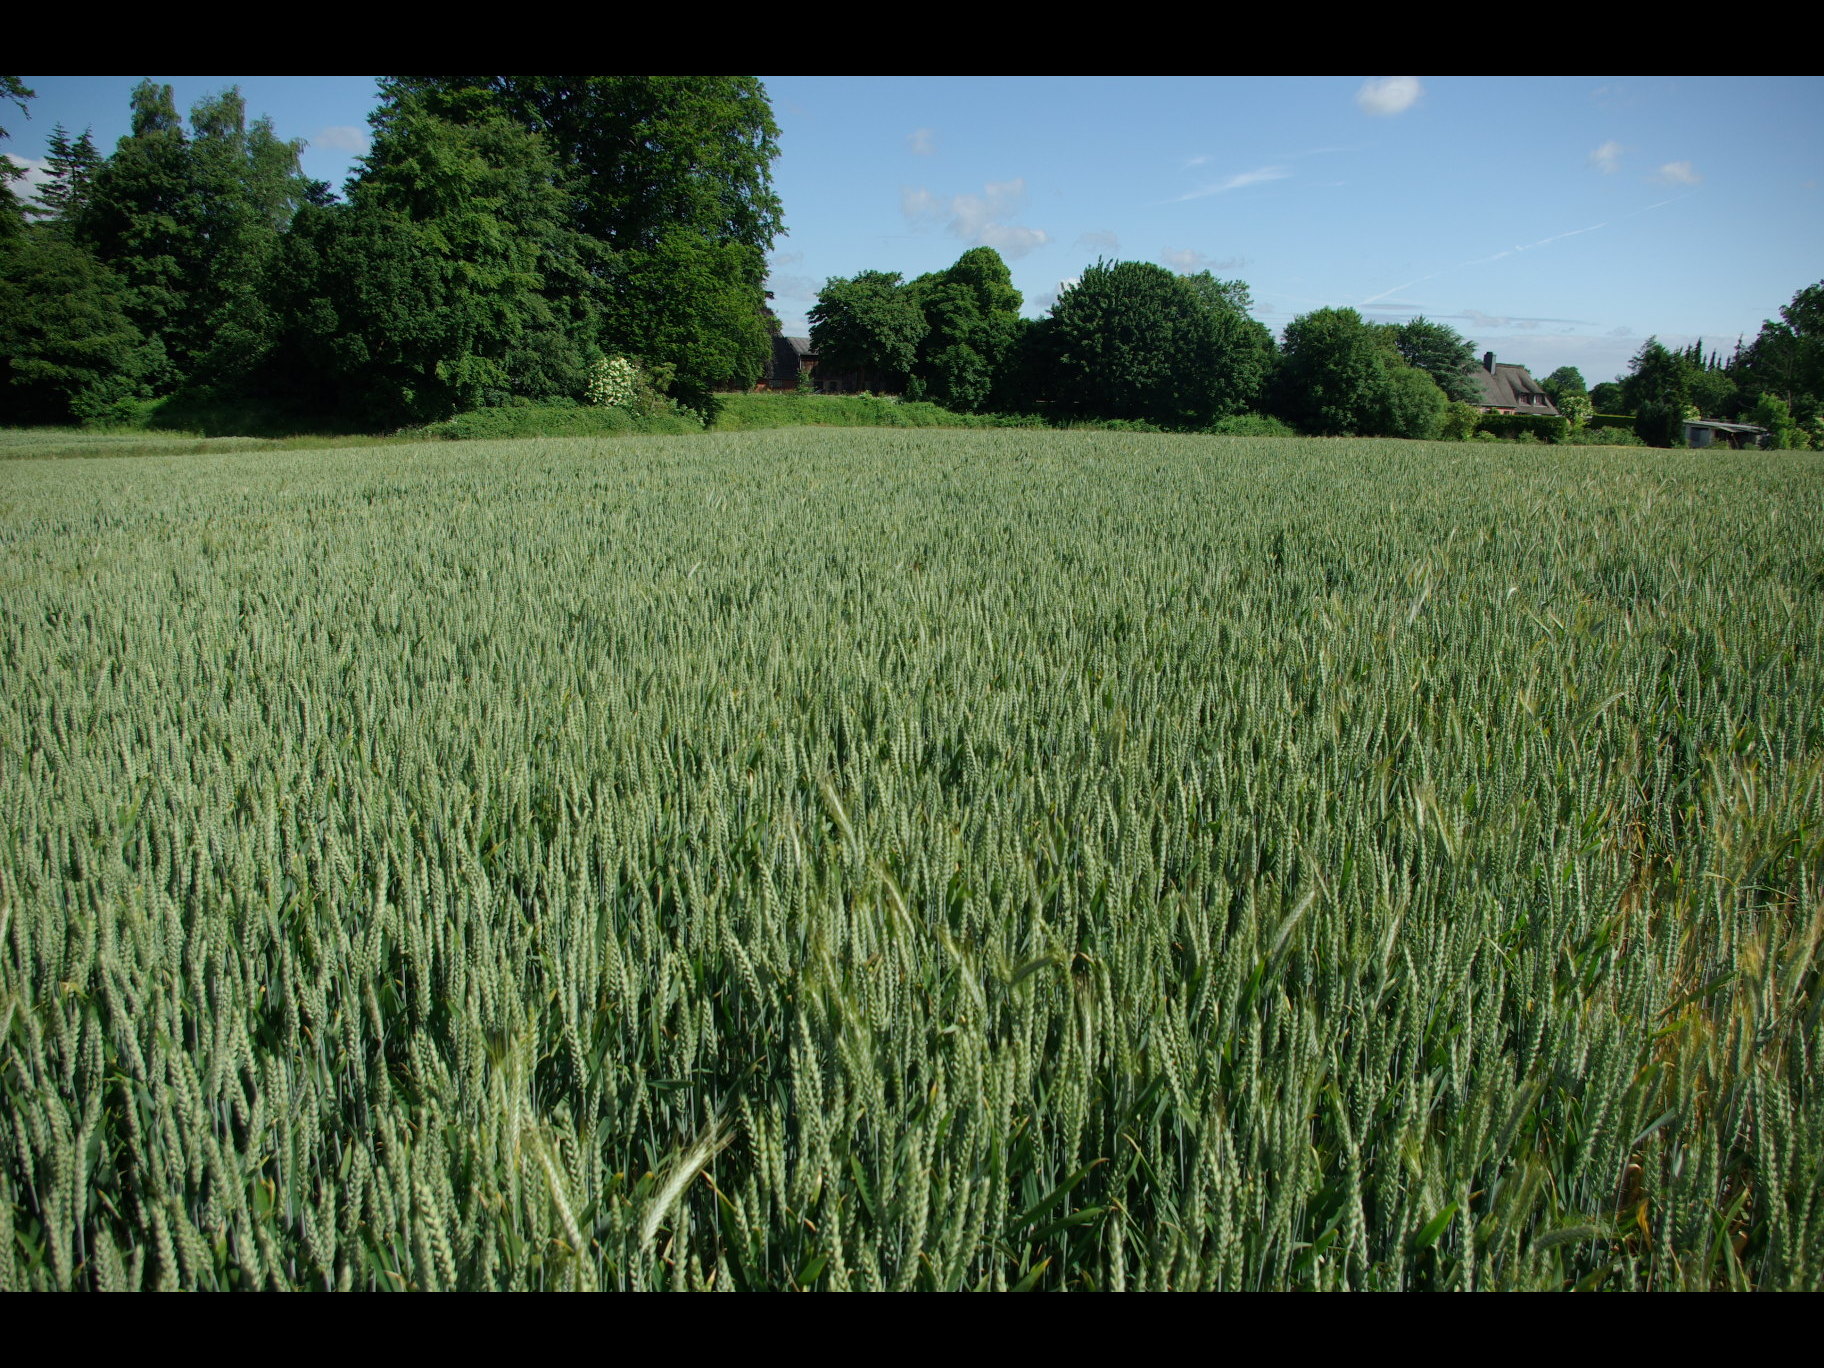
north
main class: Cropland
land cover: Common wheat
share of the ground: > 75 %
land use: Agriculture (excluding fallow land and kitchen gardens)
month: June
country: DE
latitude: 54.3904
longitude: 9.9231
